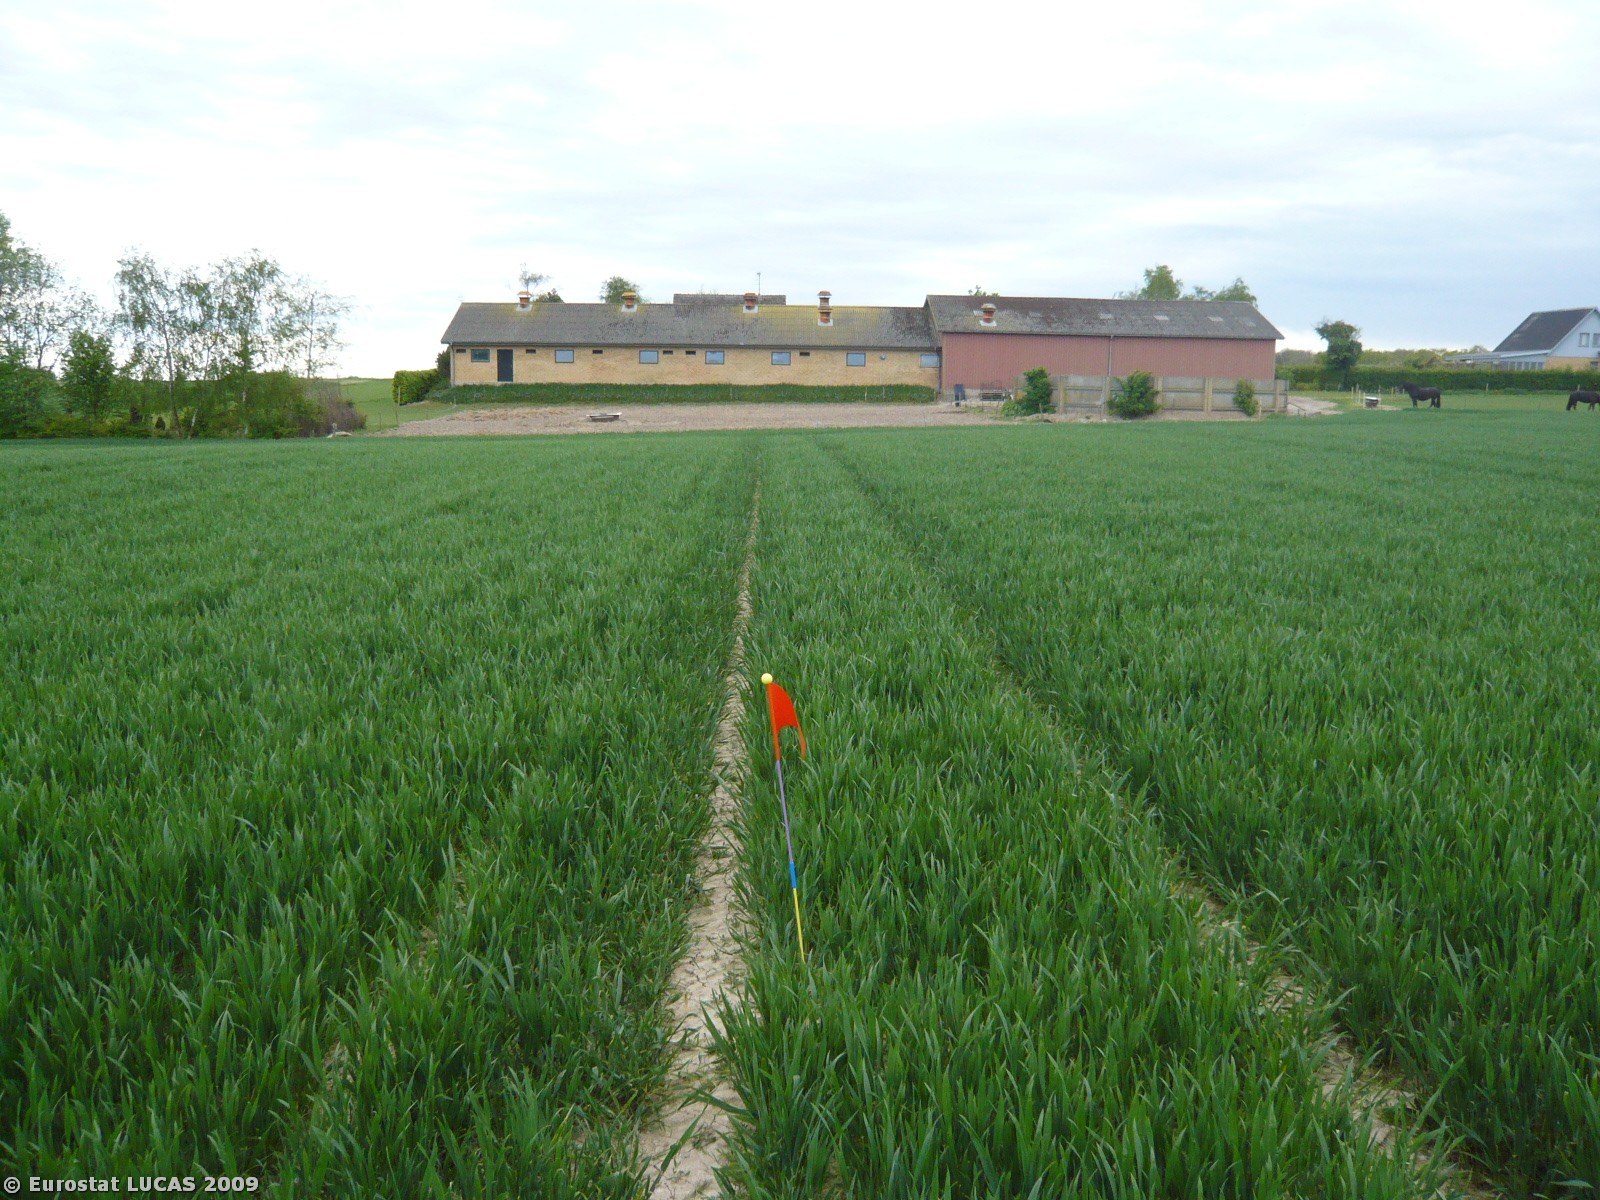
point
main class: Cropland
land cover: Common wheat
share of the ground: > 75 %
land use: Agriculture (excluding fallow land and kitchen gardens)
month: May
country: DK
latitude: 55.1125
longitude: 11.9269
